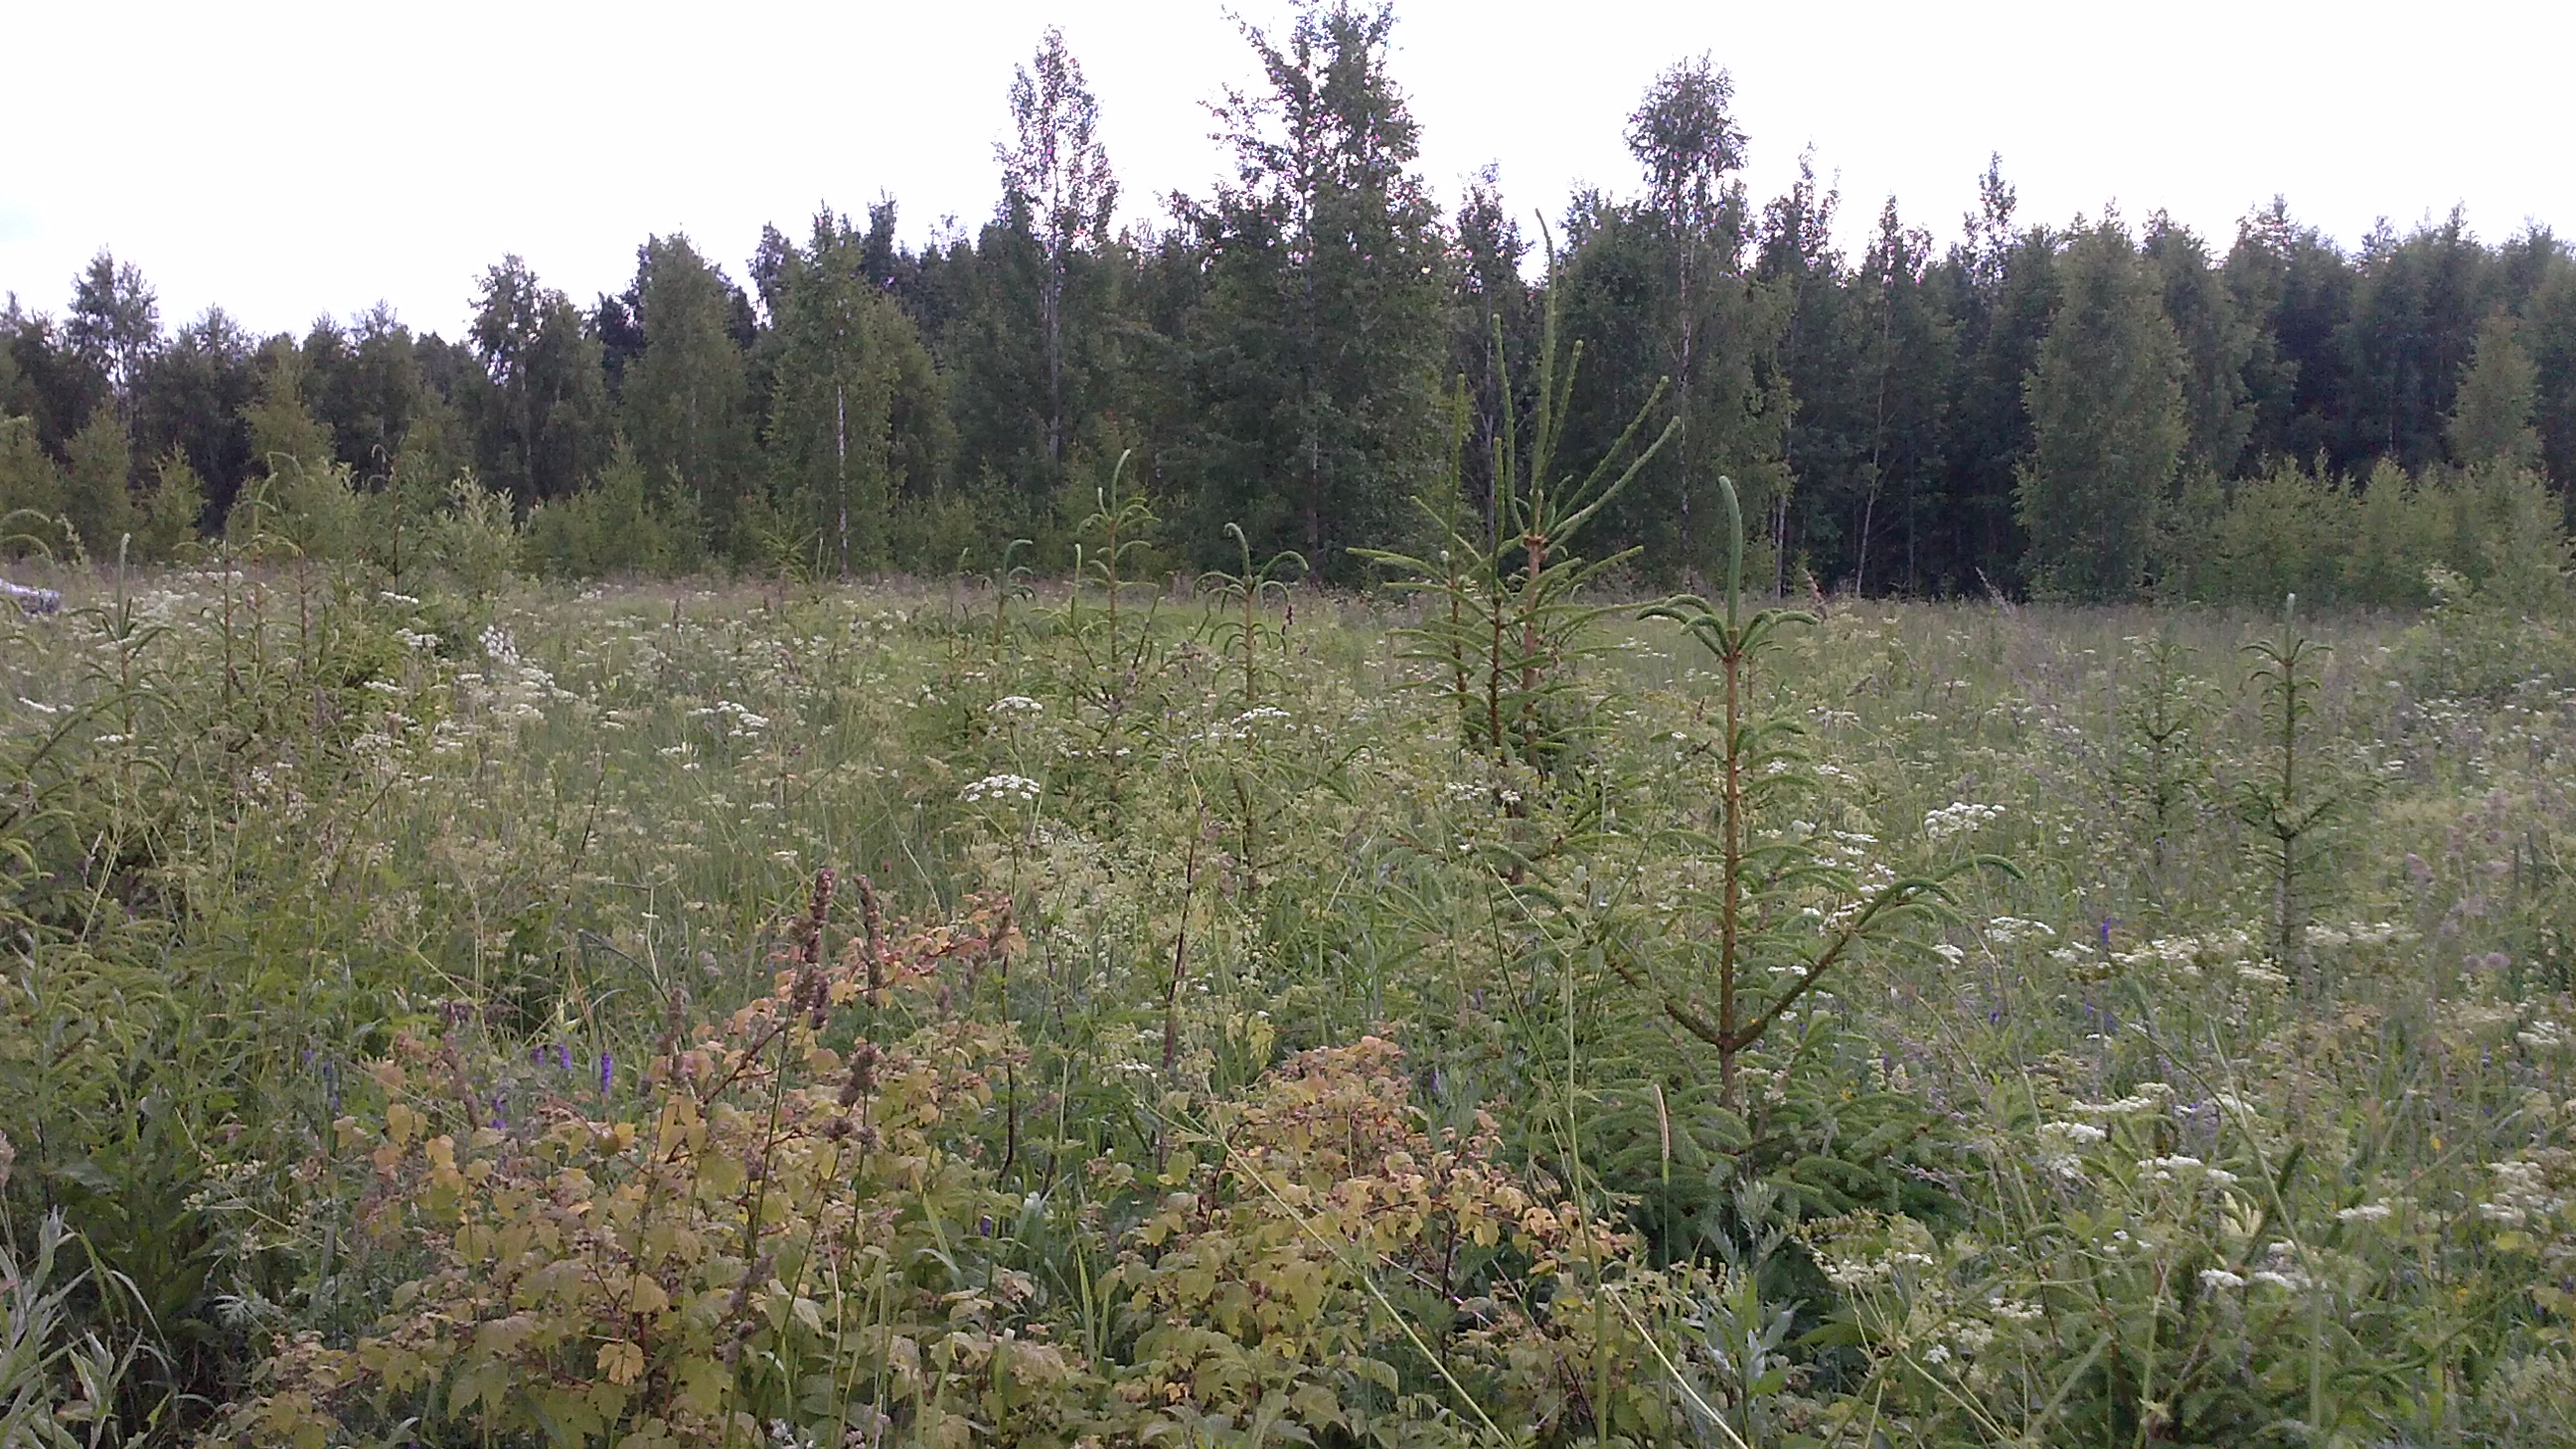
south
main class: Grassland
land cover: Grassland with sparse tree/shrub cover
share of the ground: > 75 %
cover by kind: herbaceous plants 90 %, coniferous forest trees 5 %, shrubs 5 %
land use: Forestry
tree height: < 5 m
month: June
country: LV
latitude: 56.5043
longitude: 27.8856
